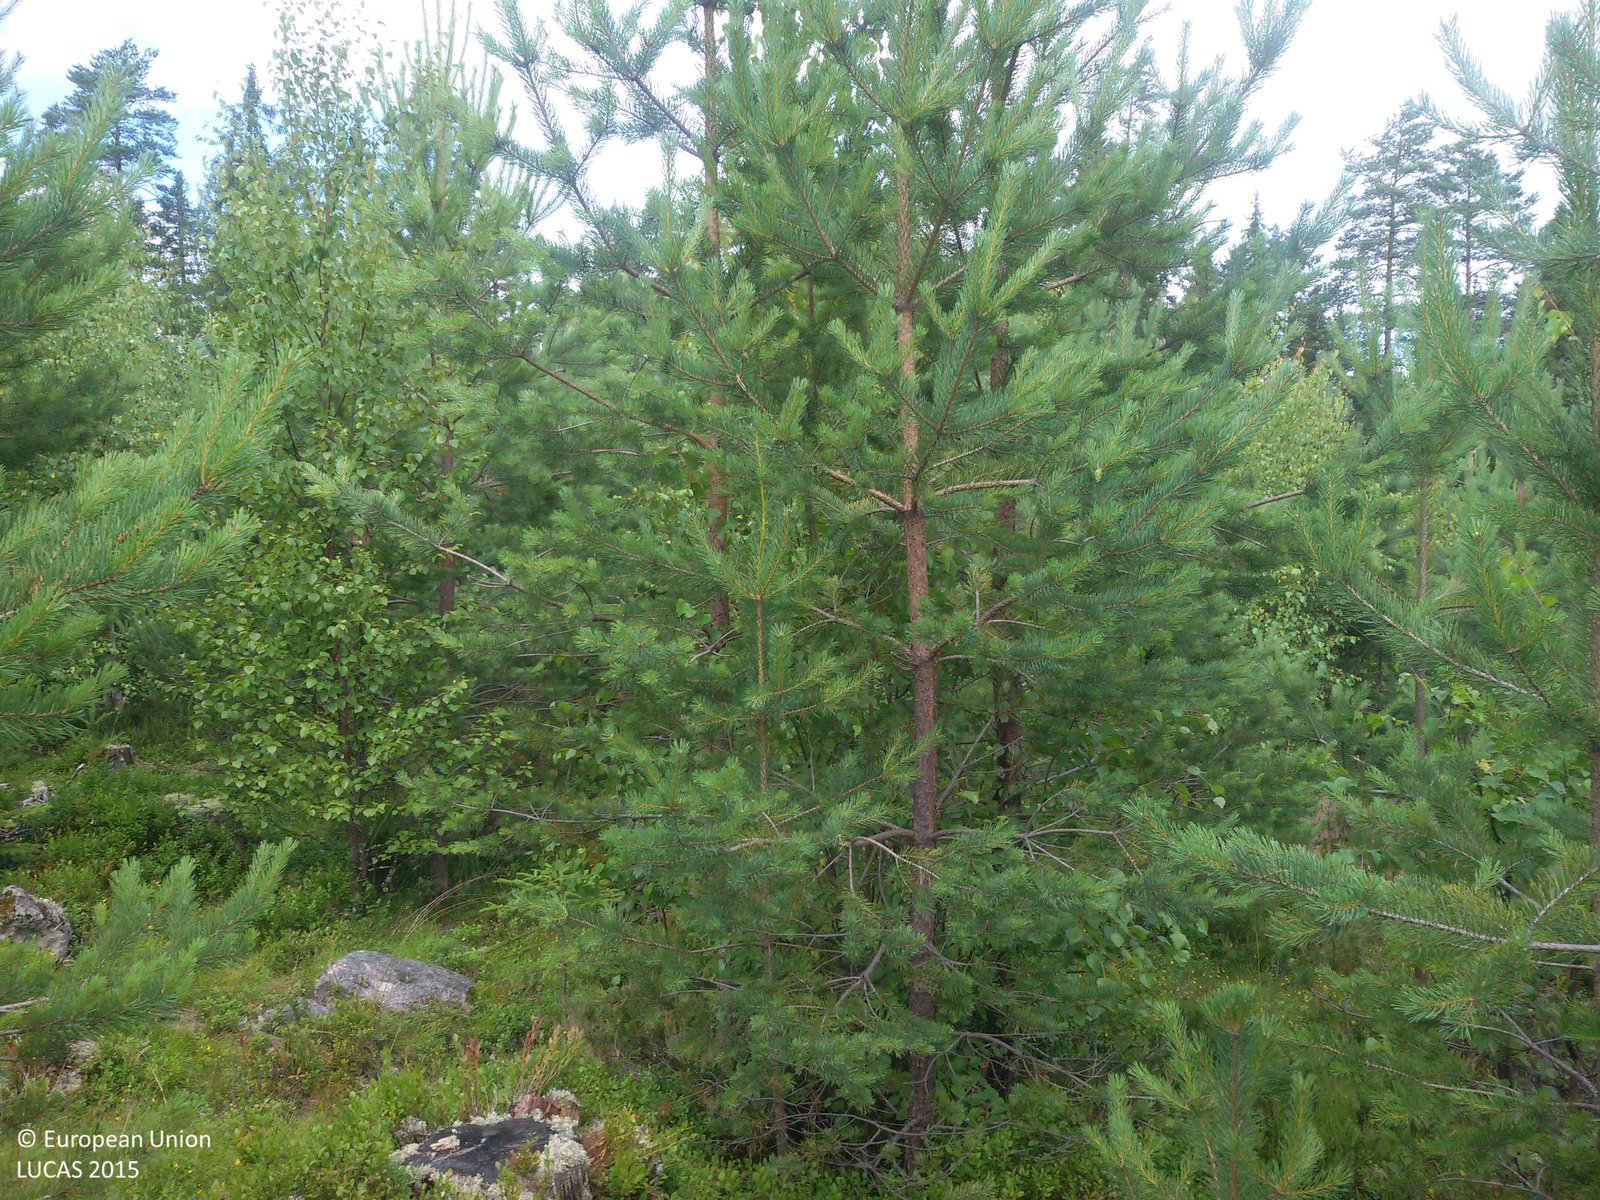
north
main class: Woodland
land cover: Pine dominated mixed woodland
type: boreal forest
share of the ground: > 75 %
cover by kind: coniferous forest trees 50 %, broadleaved forest trees 30 %, shrubs 15 %, lichens and mosses 5 %
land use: Forestry
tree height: < 5 m
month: July
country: SE
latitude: 60.5279
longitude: 15.8732
